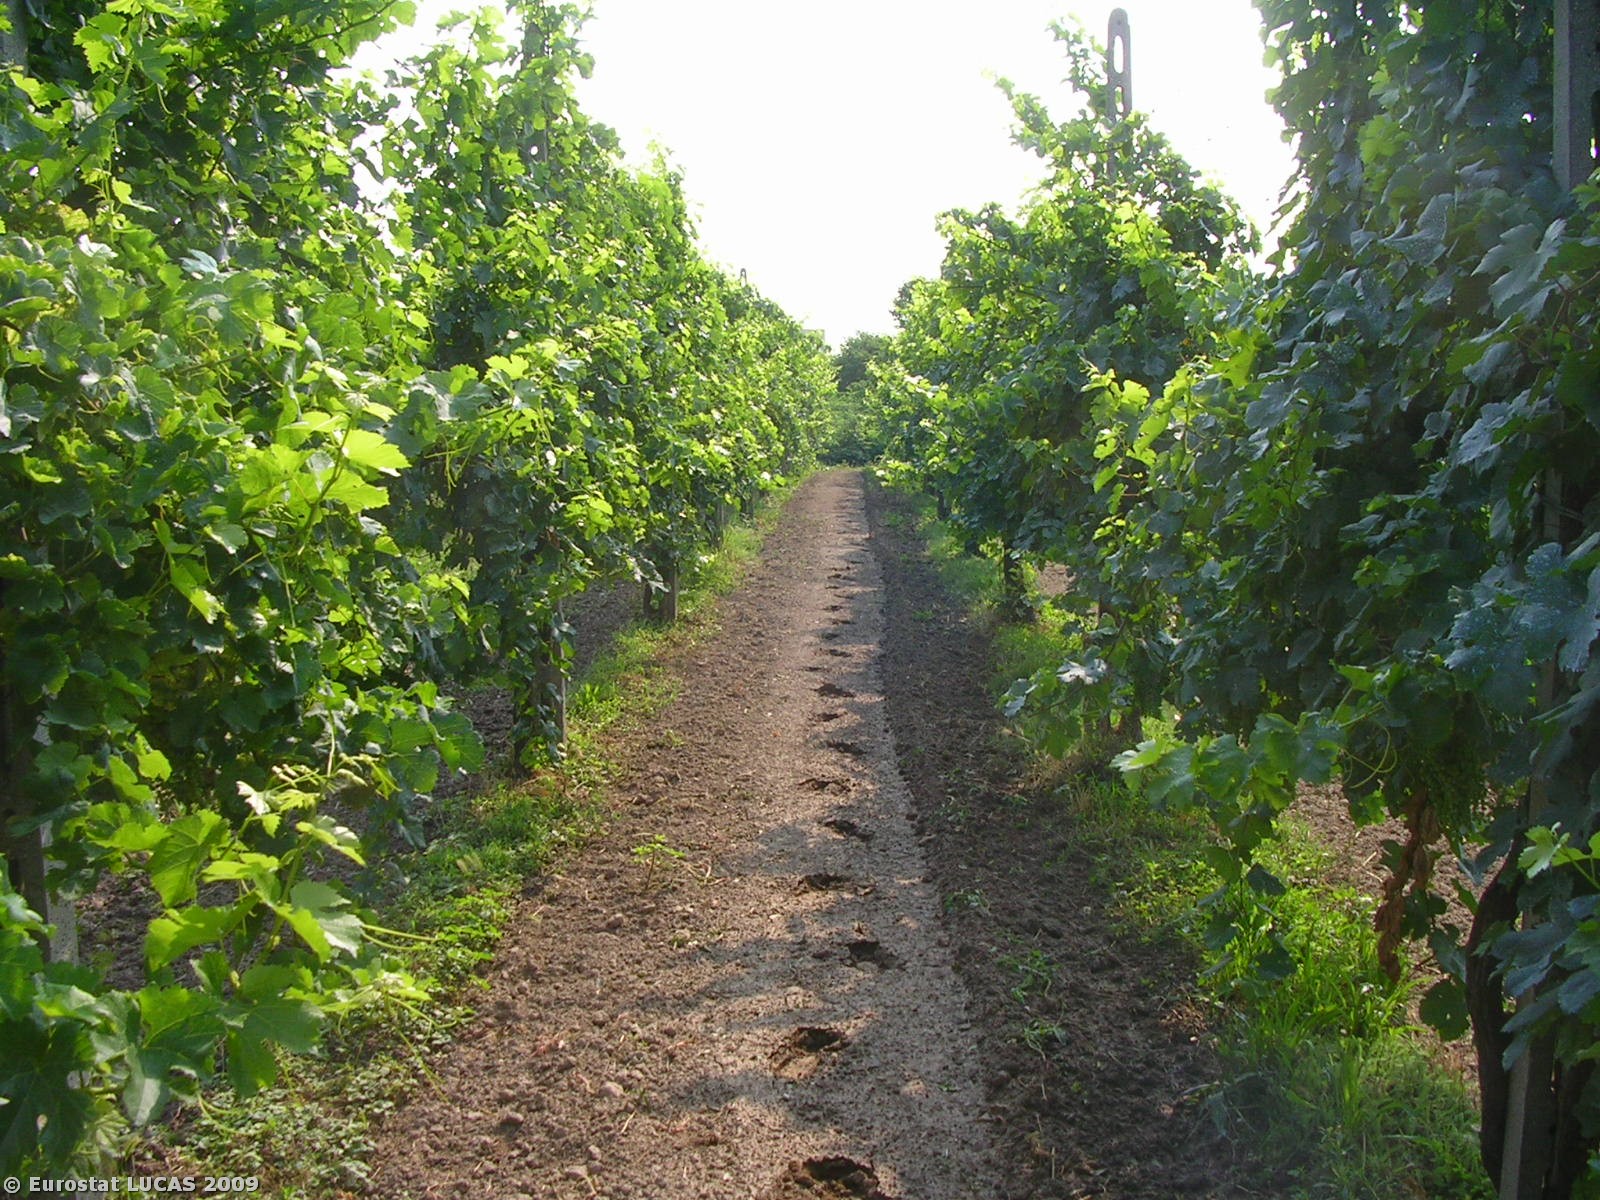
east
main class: Cropland
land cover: Vineyards
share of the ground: 50 - 75 %
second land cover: Bare land
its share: 50 - 75 %
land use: Agriculture (excluding fallow land and kitchen gardens)
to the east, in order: Vineyards; Bare land; Grass margins; Paved roads, cycling and walking lanes; Grass margins; Ditches and canals; Broadleaved woodland; Fences; Artificial constructions in urban areas
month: July
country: IT
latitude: 45.2196
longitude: 11.7416
